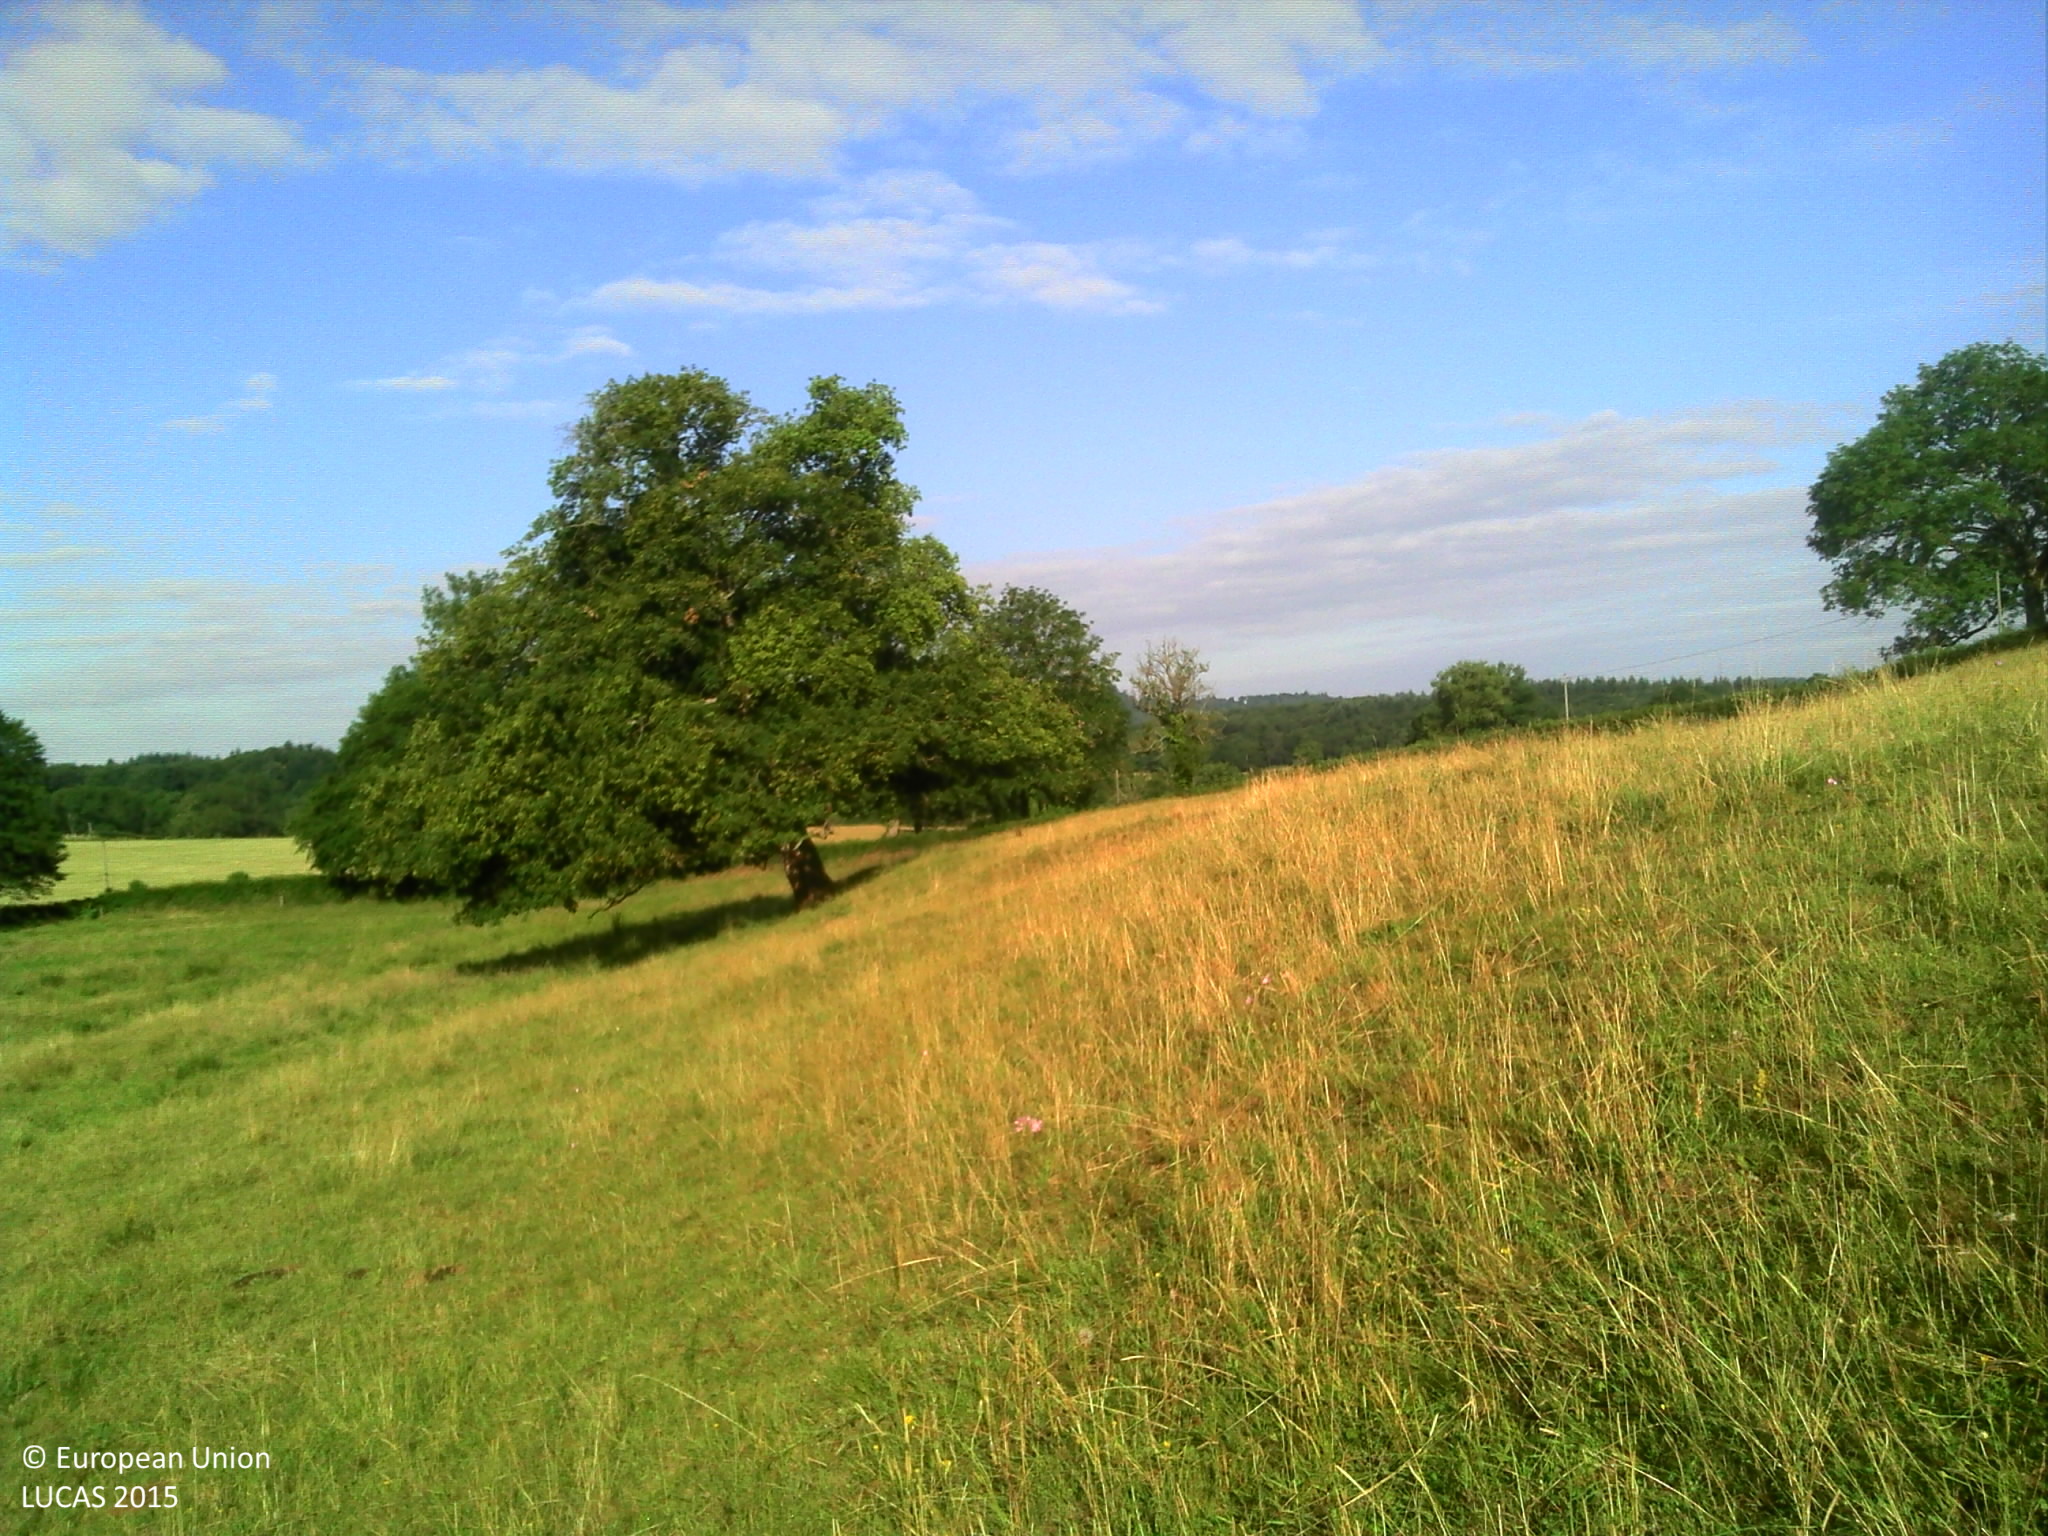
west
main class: Grassland
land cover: Grassland without tree/shrub cover
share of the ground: > 75 %
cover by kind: herbaceous plants 100 %
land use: Agriculture (excluding fallow land and kitchen gardens)
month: June
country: FR
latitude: 46.4967
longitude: 4.4637
